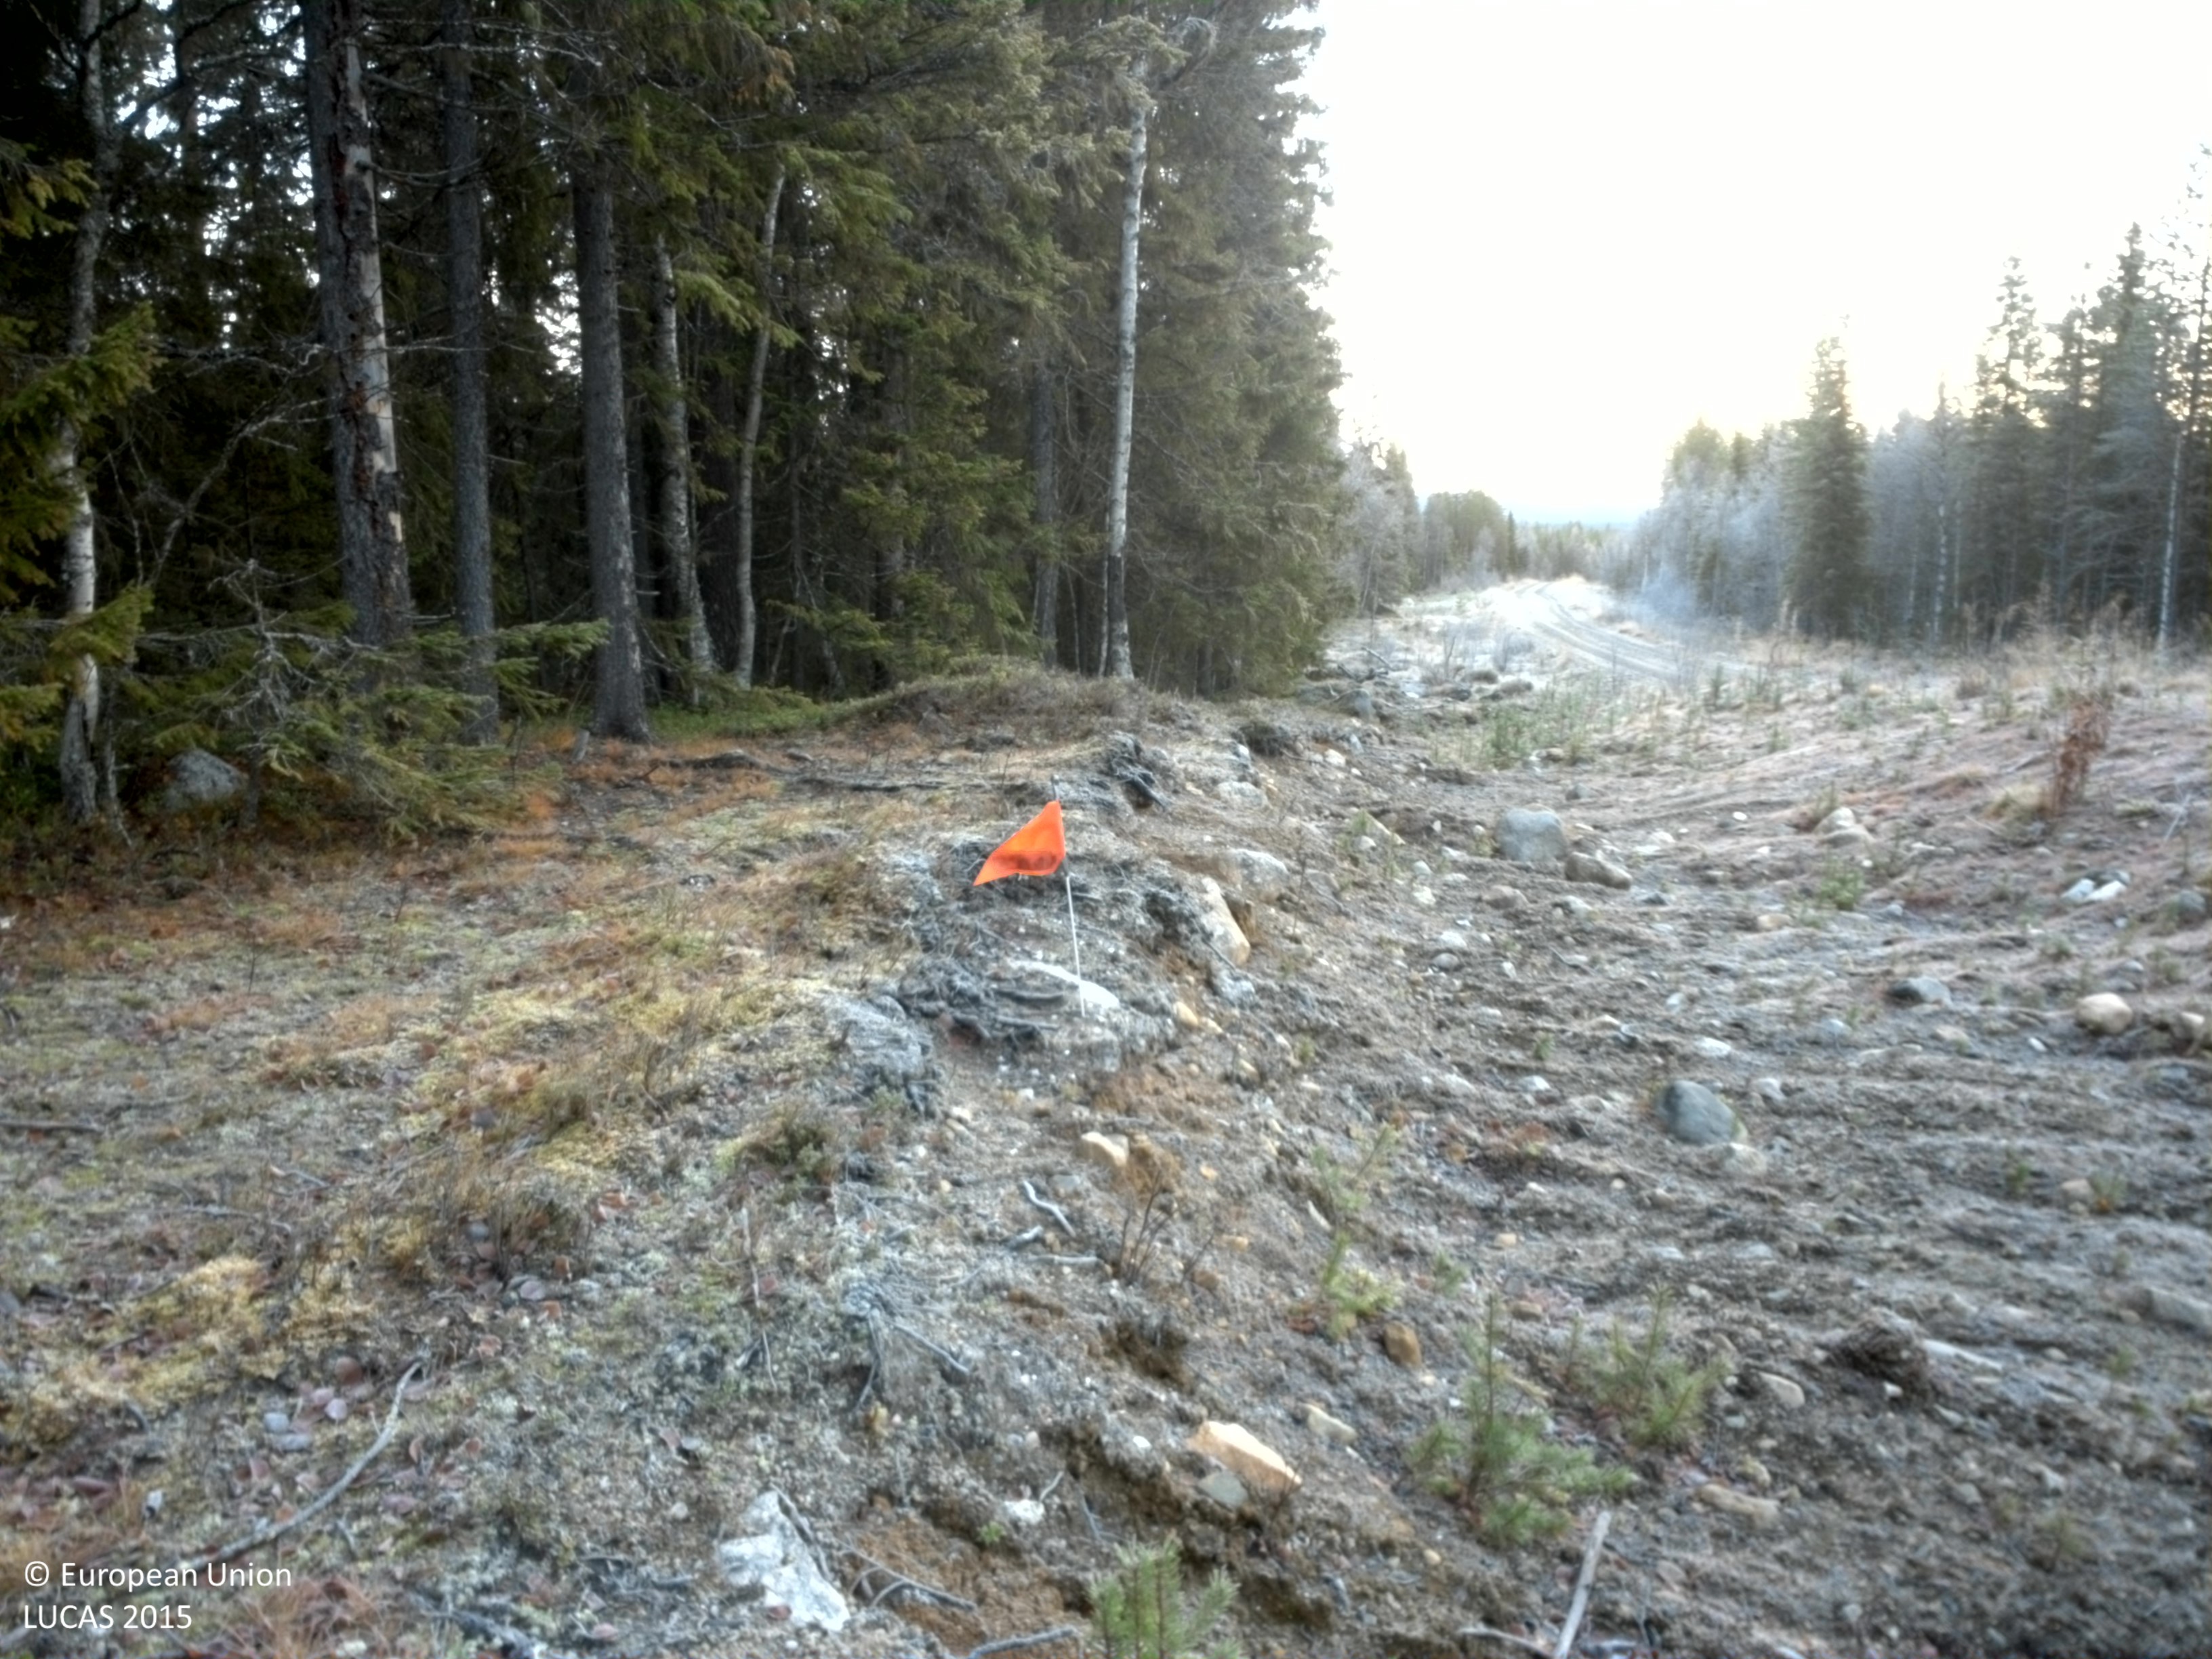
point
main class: Woodland
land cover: Spruce dominated coniferous woodland
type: boreal forest
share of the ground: 50 - 75 %
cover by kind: coniferous forest trees 50 %, shrubs 25 %, broadleaved forest trees 10 %, lichens and mosses 10 %, herbaceous plants 5 %
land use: Forestry
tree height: > 5 m
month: October
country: SE
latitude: 64.5015
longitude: 17.3165
